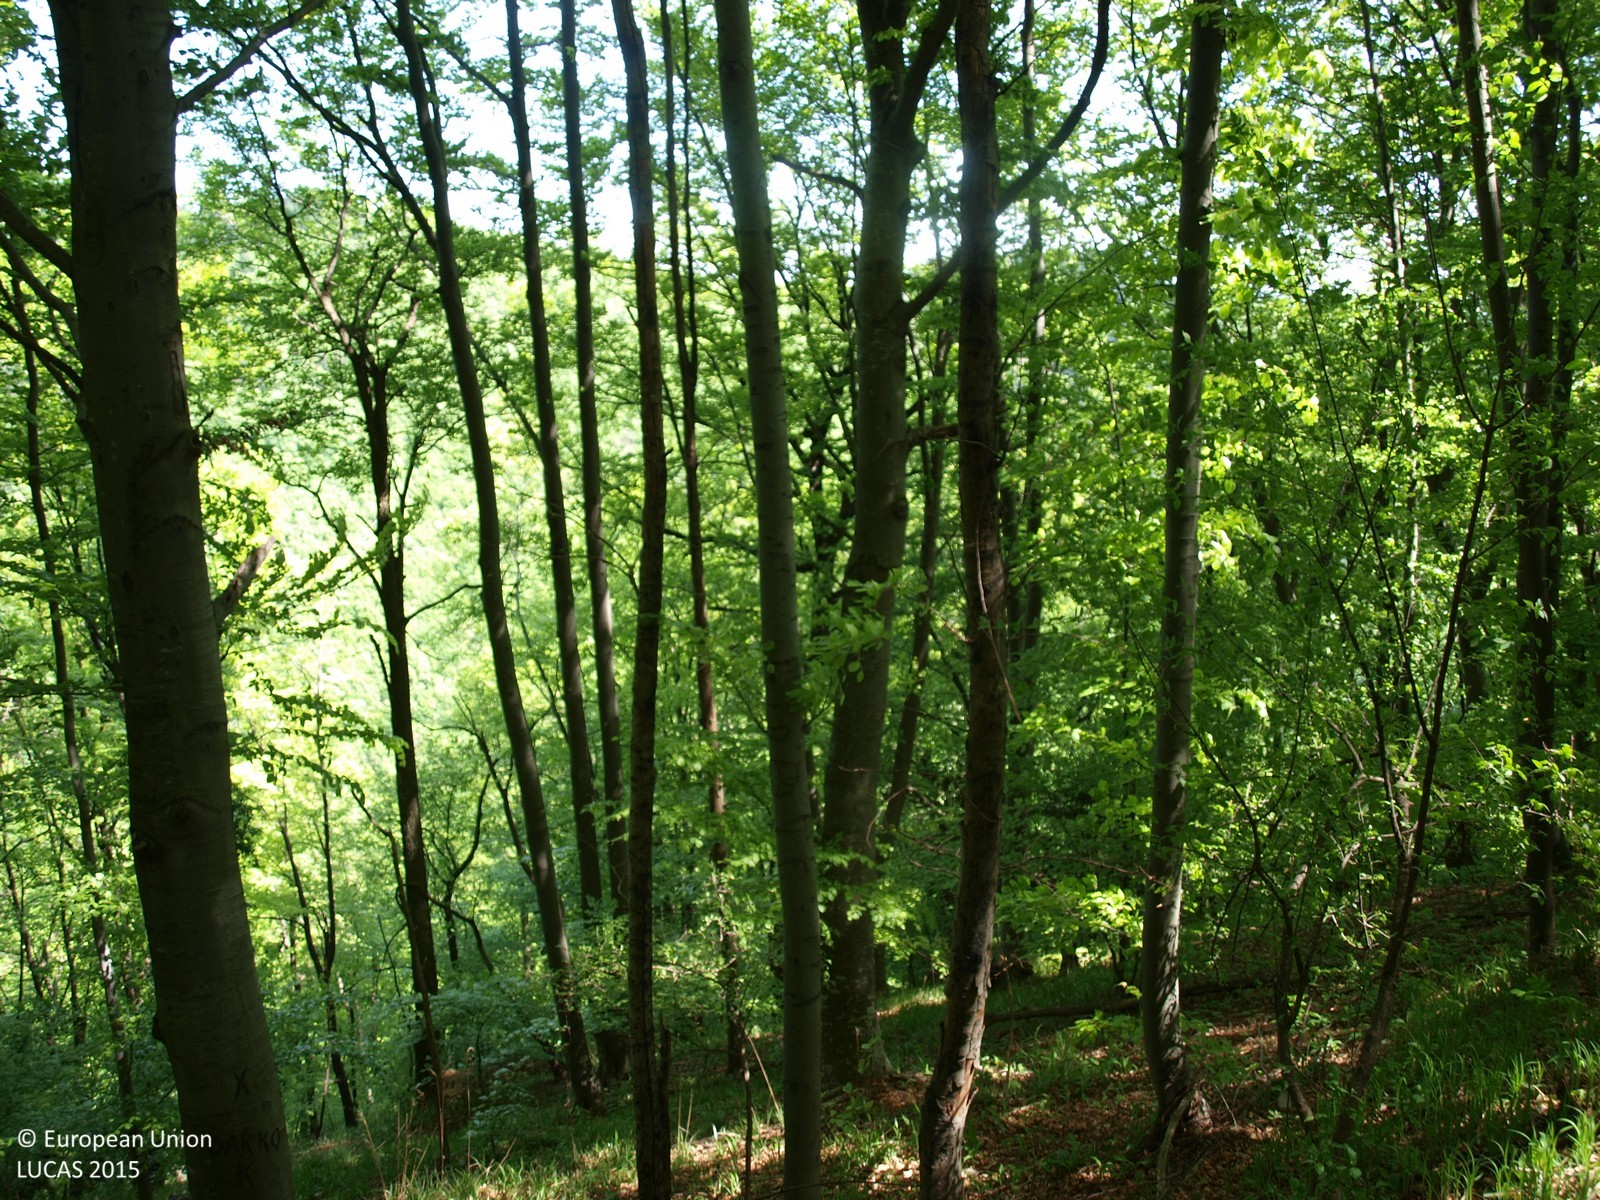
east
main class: Woodland
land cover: Broadleaved woodland
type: beech forest
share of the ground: > 75 %
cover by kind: broadleaved forest trees 100 %
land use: Forestry
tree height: > 5 m
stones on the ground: < 10 %
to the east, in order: Broadleaved woodland; Rivers and streams; Broadleaved woodland; Grass margins; Paved roads, cycling and walking lanes; Grass margins; Ditches and canals; Spruce dominated coniferous woodland
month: April
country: HR
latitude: 46.2712
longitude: 16.0331
